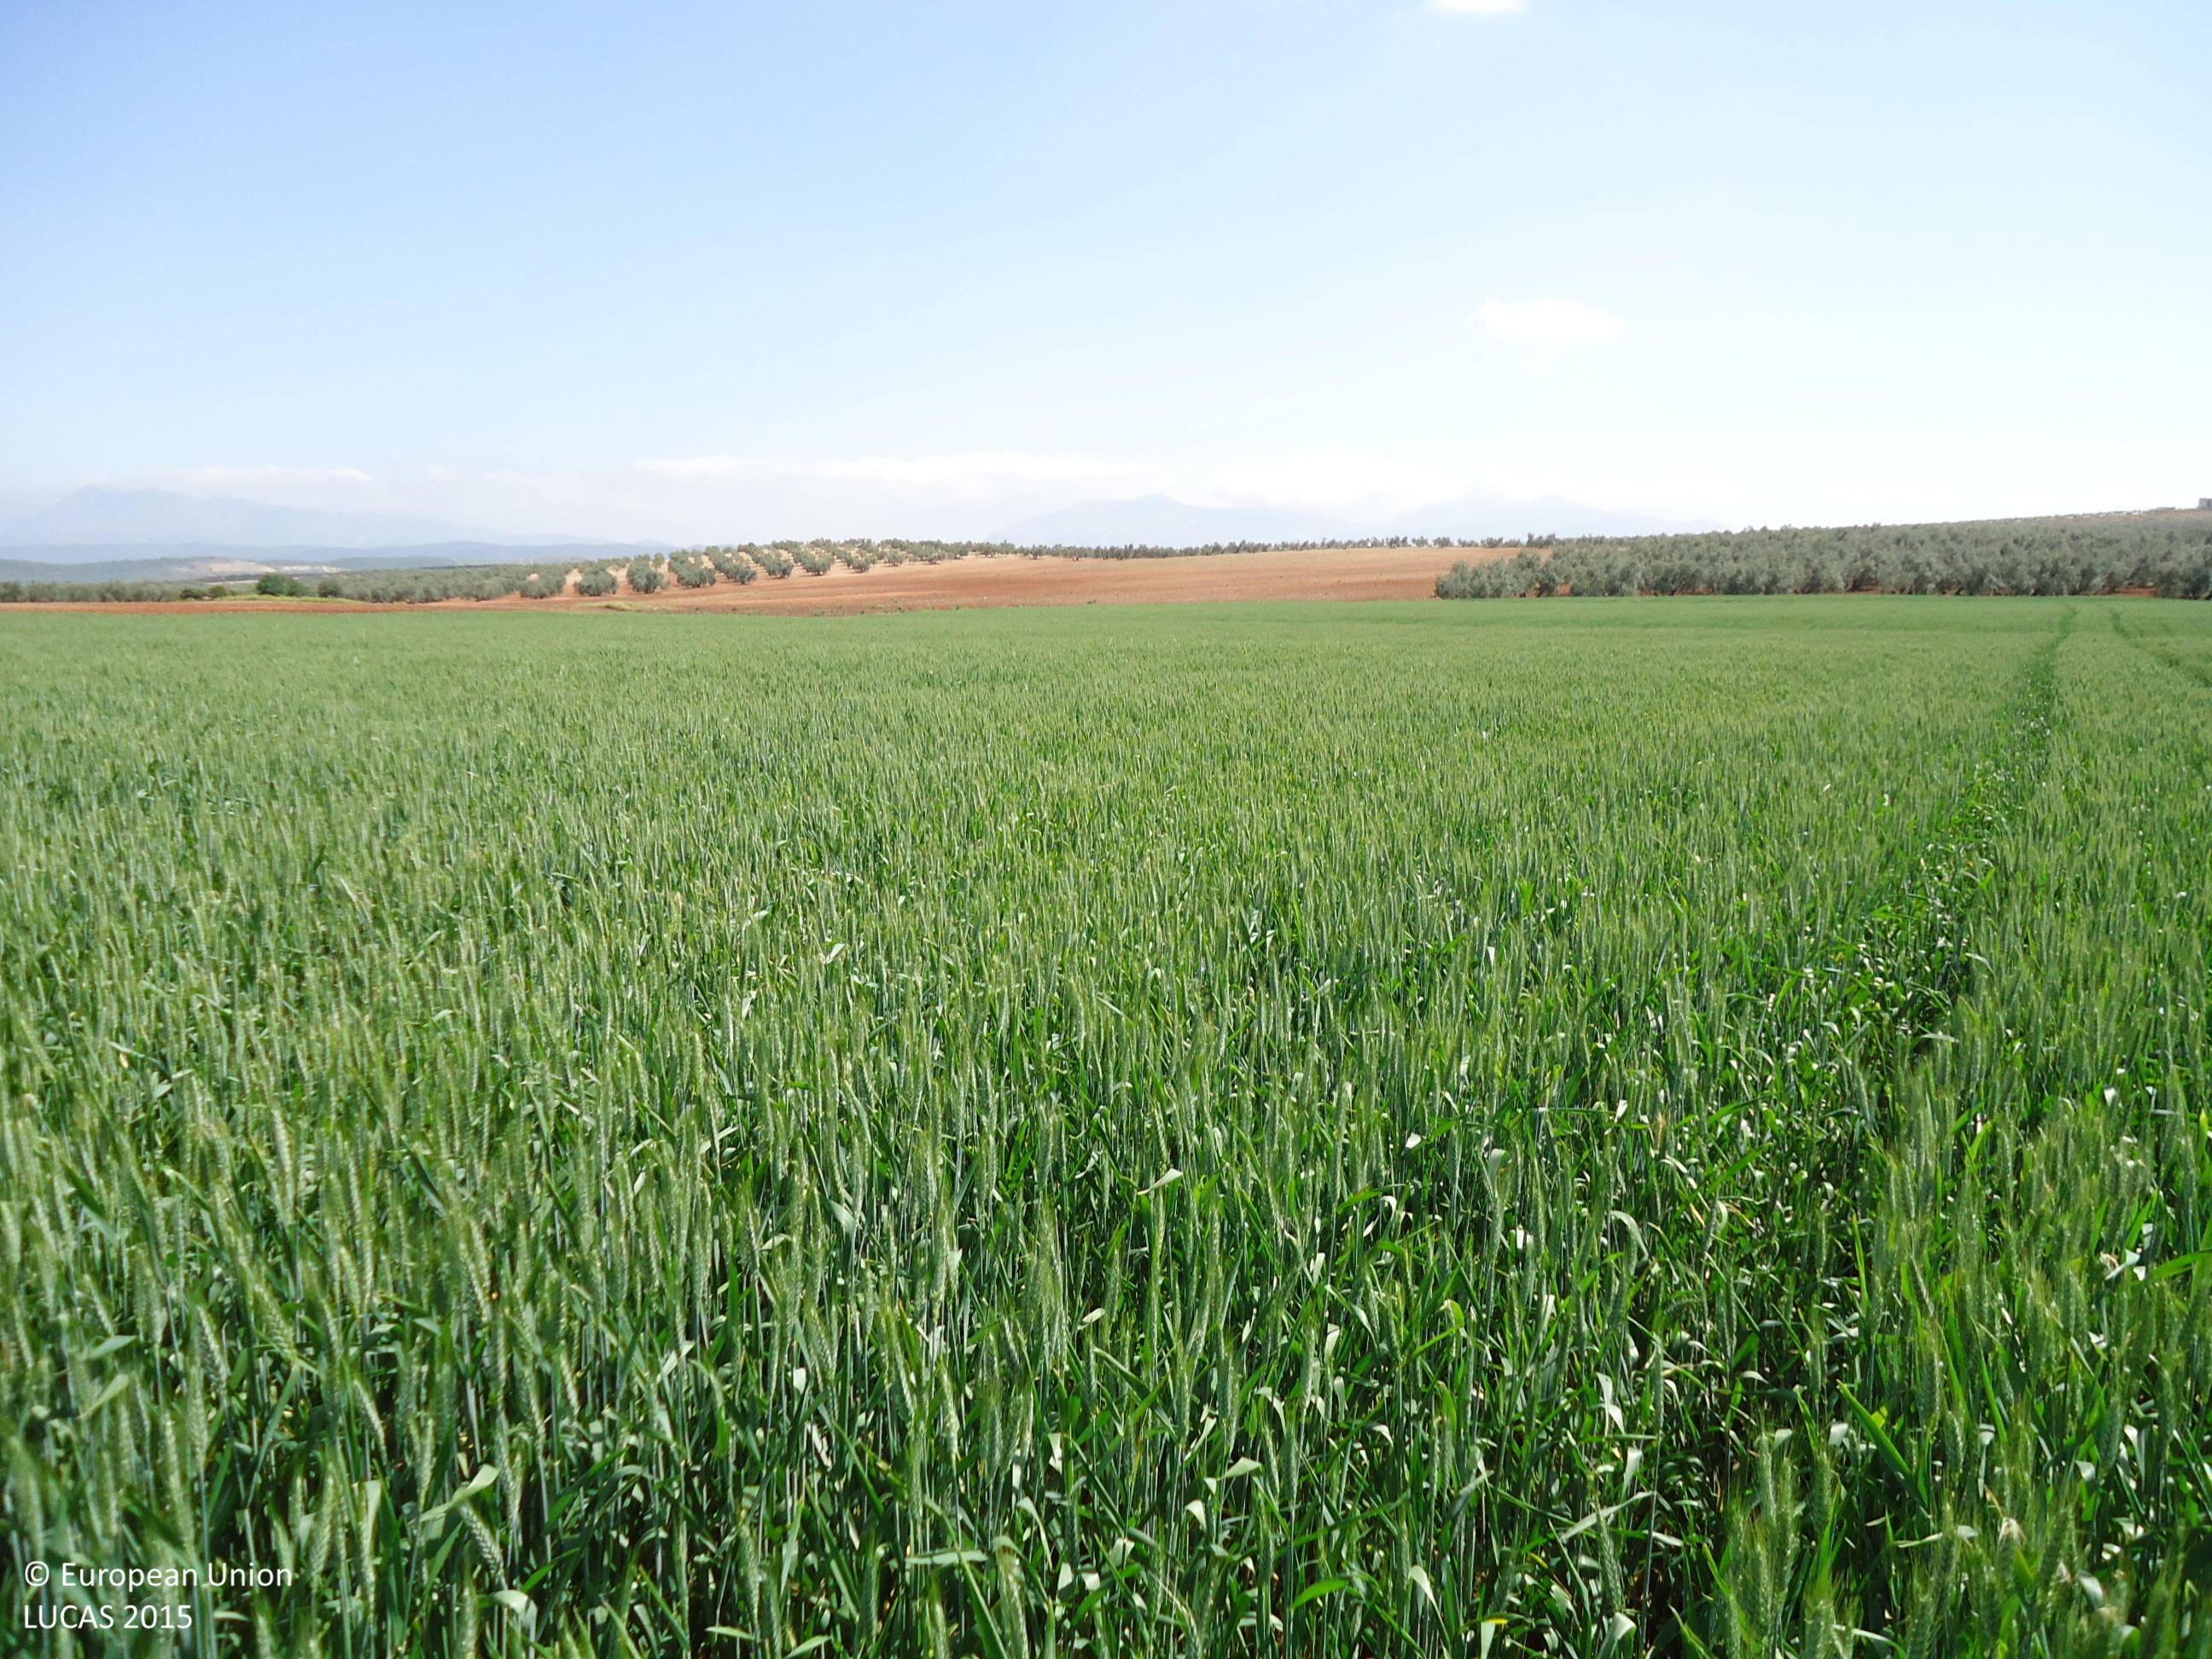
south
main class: Cropland
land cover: Common wheat
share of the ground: > 75 %
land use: Agriculture (excluding fallow land and kitchen gardens)
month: April
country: ES
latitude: 37.0627
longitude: -4.7891
